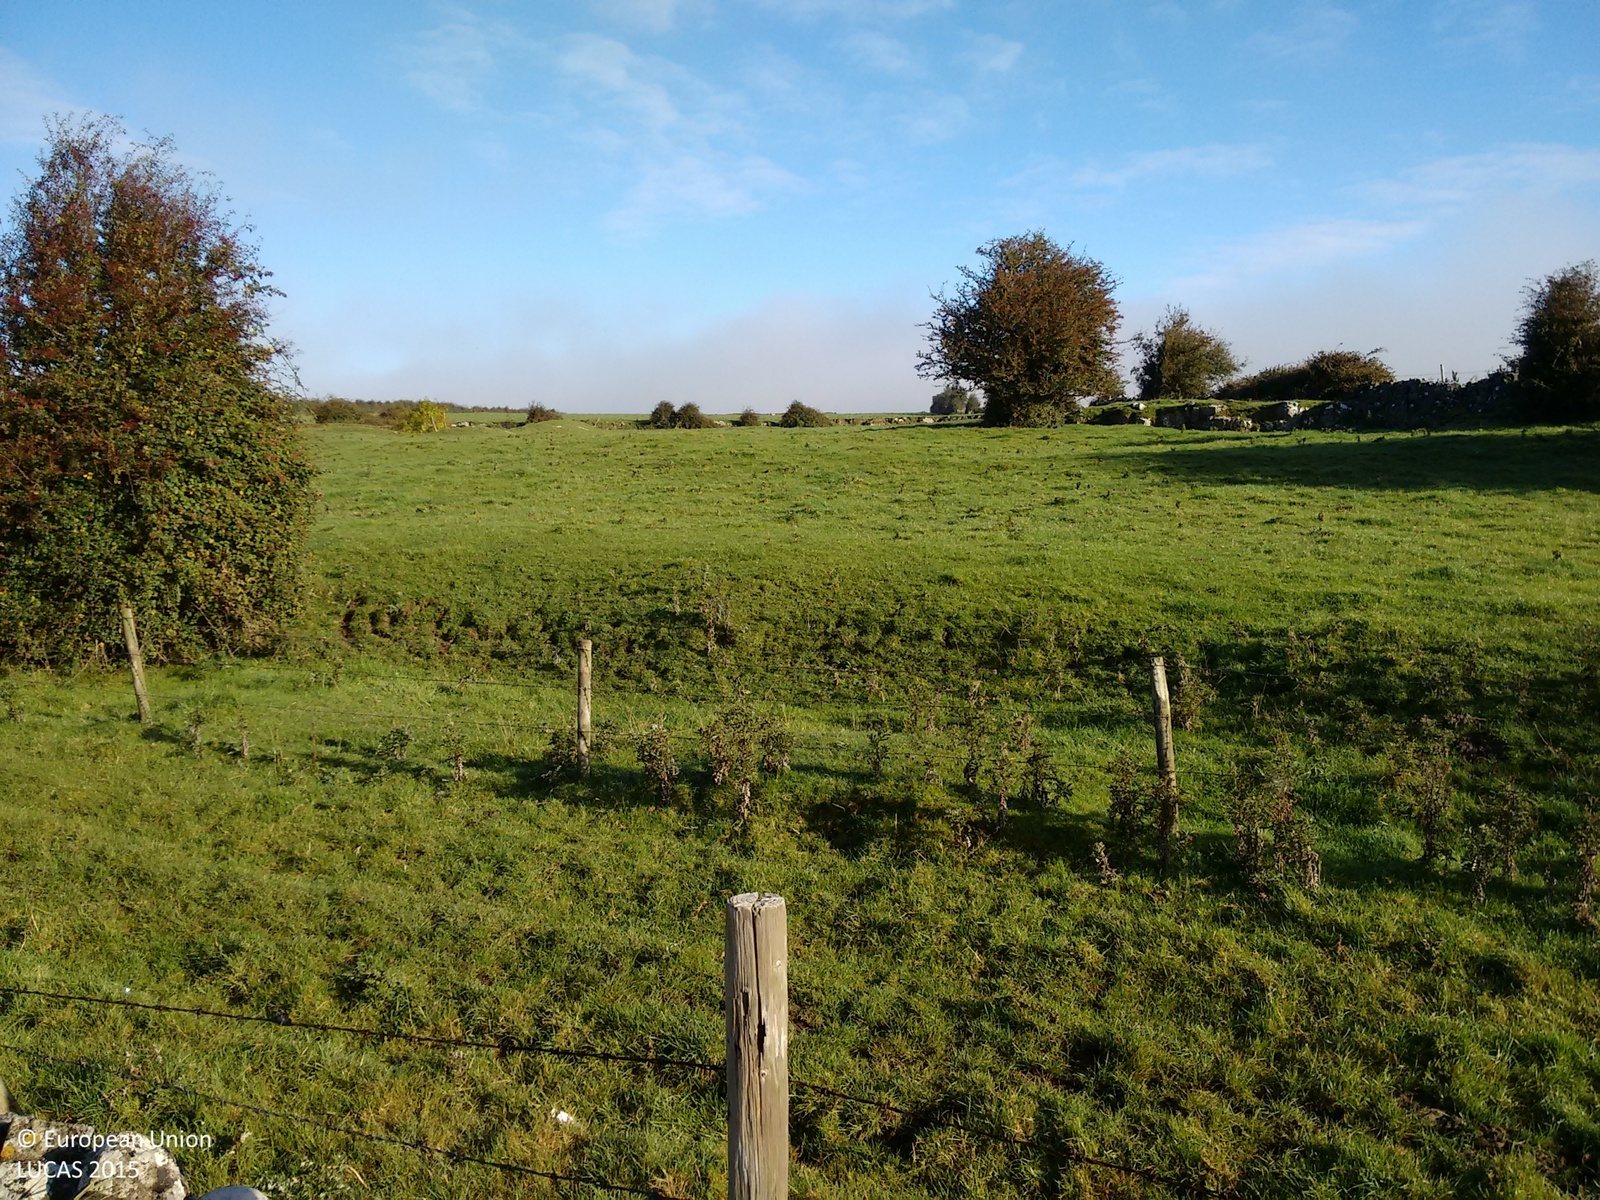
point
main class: Grassland
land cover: Grassland without tree/shrub cover
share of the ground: > 75 %
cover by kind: herbaceous plants 90 %
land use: Agriculture (excluding fallow land and kitchen gardens)
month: October
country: IE
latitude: 53.7743
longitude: -8.2241
